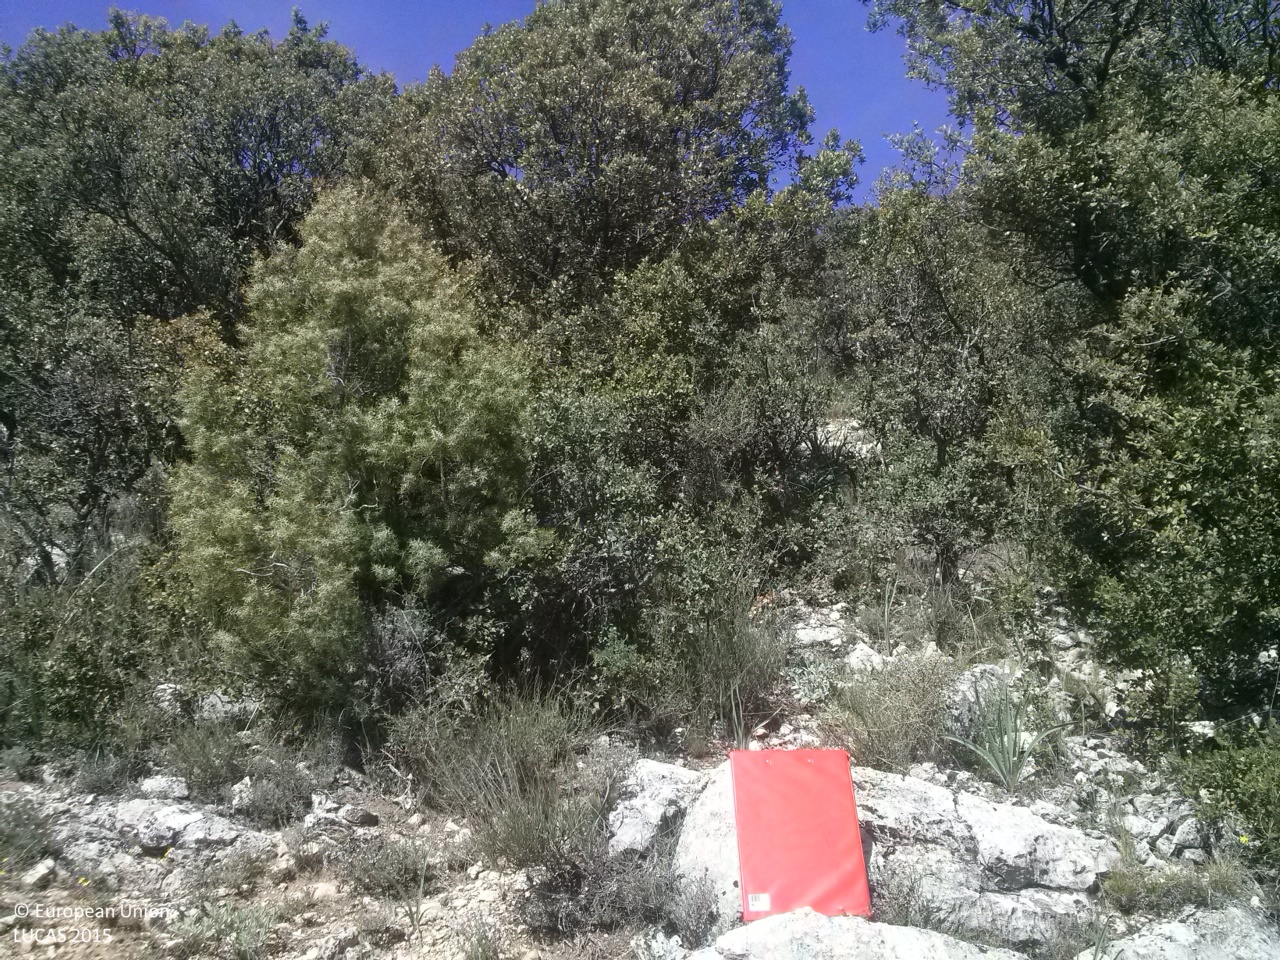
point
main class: Woodland
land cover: Broadleaved woodland
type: broadleaved evergreen forest
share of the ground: 25 - 50 %
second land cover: Grassland without tree/shrub cover
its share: 25 - 50 %
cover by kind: broadleaved forest trees 40 %, herbaceous plants 30 %, unconsolidated bare surface 25 %, shrubs 5 %
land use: Forestry
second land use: Agriculture (excluding fallow land and kitchen gardens)
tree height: < 5 m
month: April
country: ES
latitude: 40.0661
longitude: -1.6305
